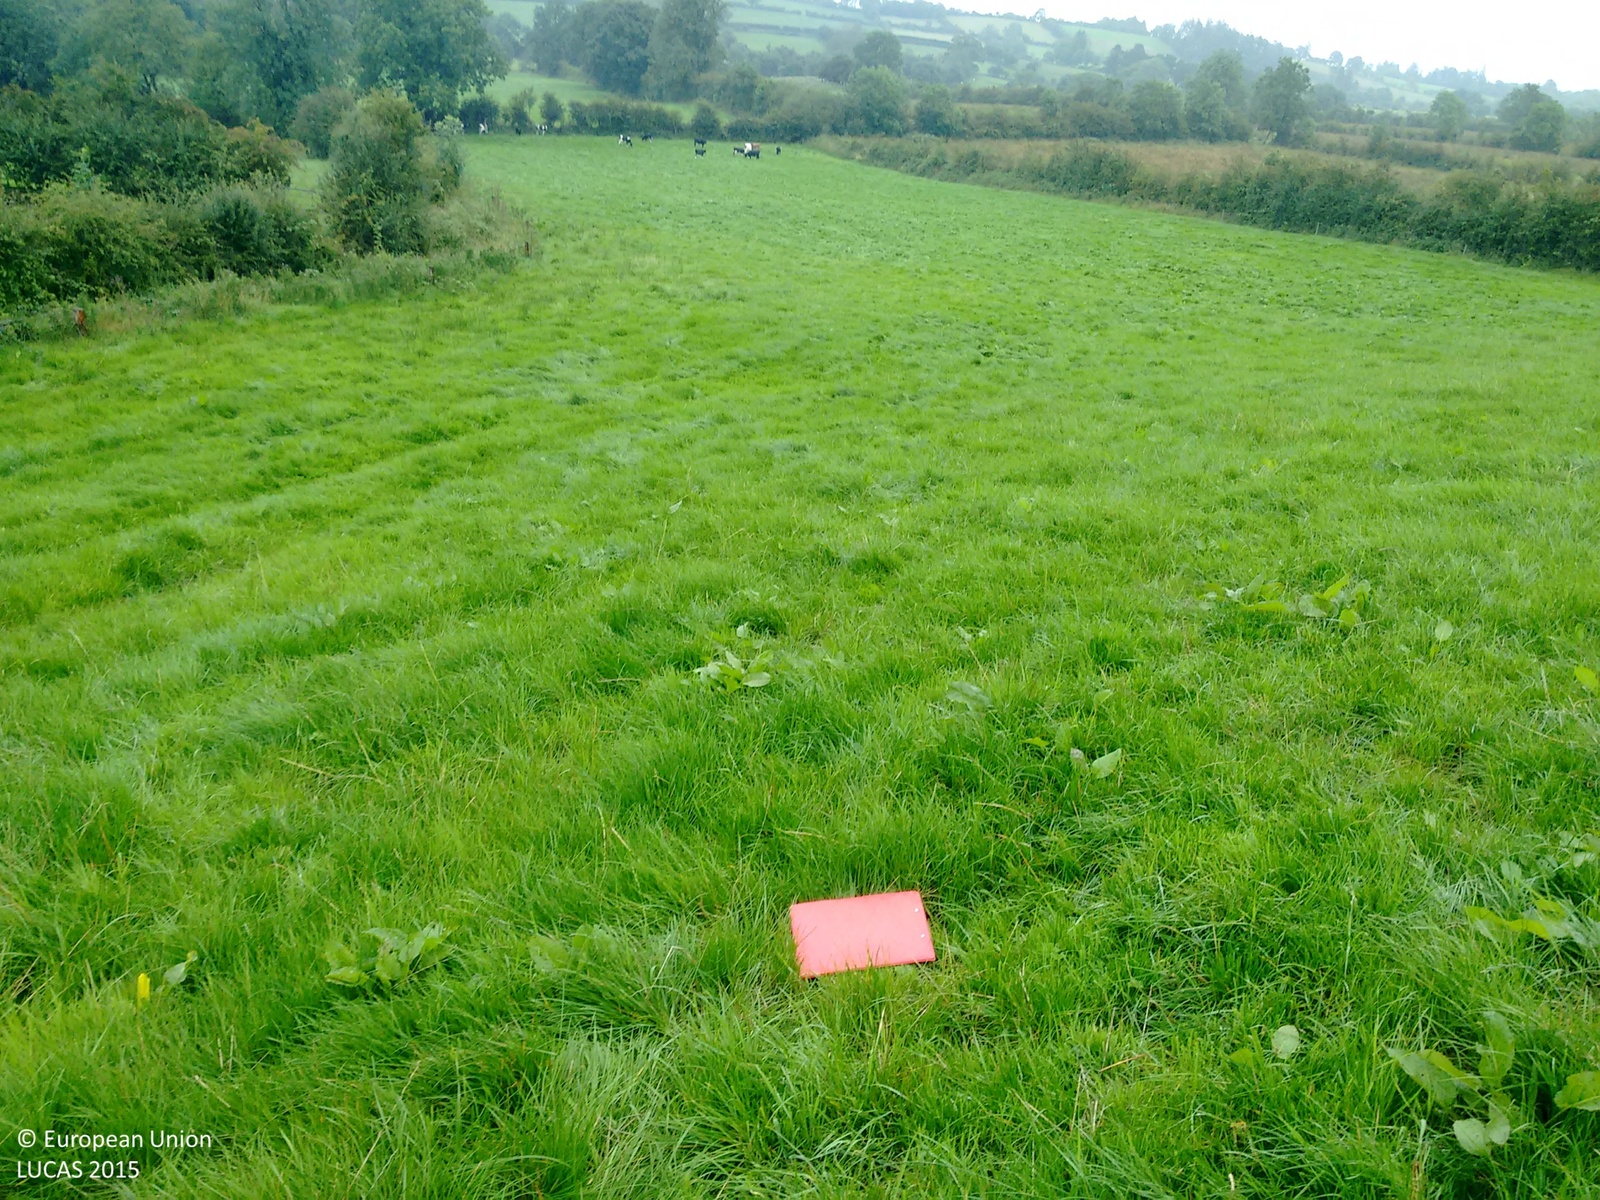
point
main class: Grassland
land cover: Grassland without tree/shrub cover
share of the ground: > 75 %
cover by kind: herbaceous plants 100 %
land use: Agriculture (excluding fallow land and kitchen gardens)
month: August
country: IE
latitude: 53.8575
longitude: -7.1592
